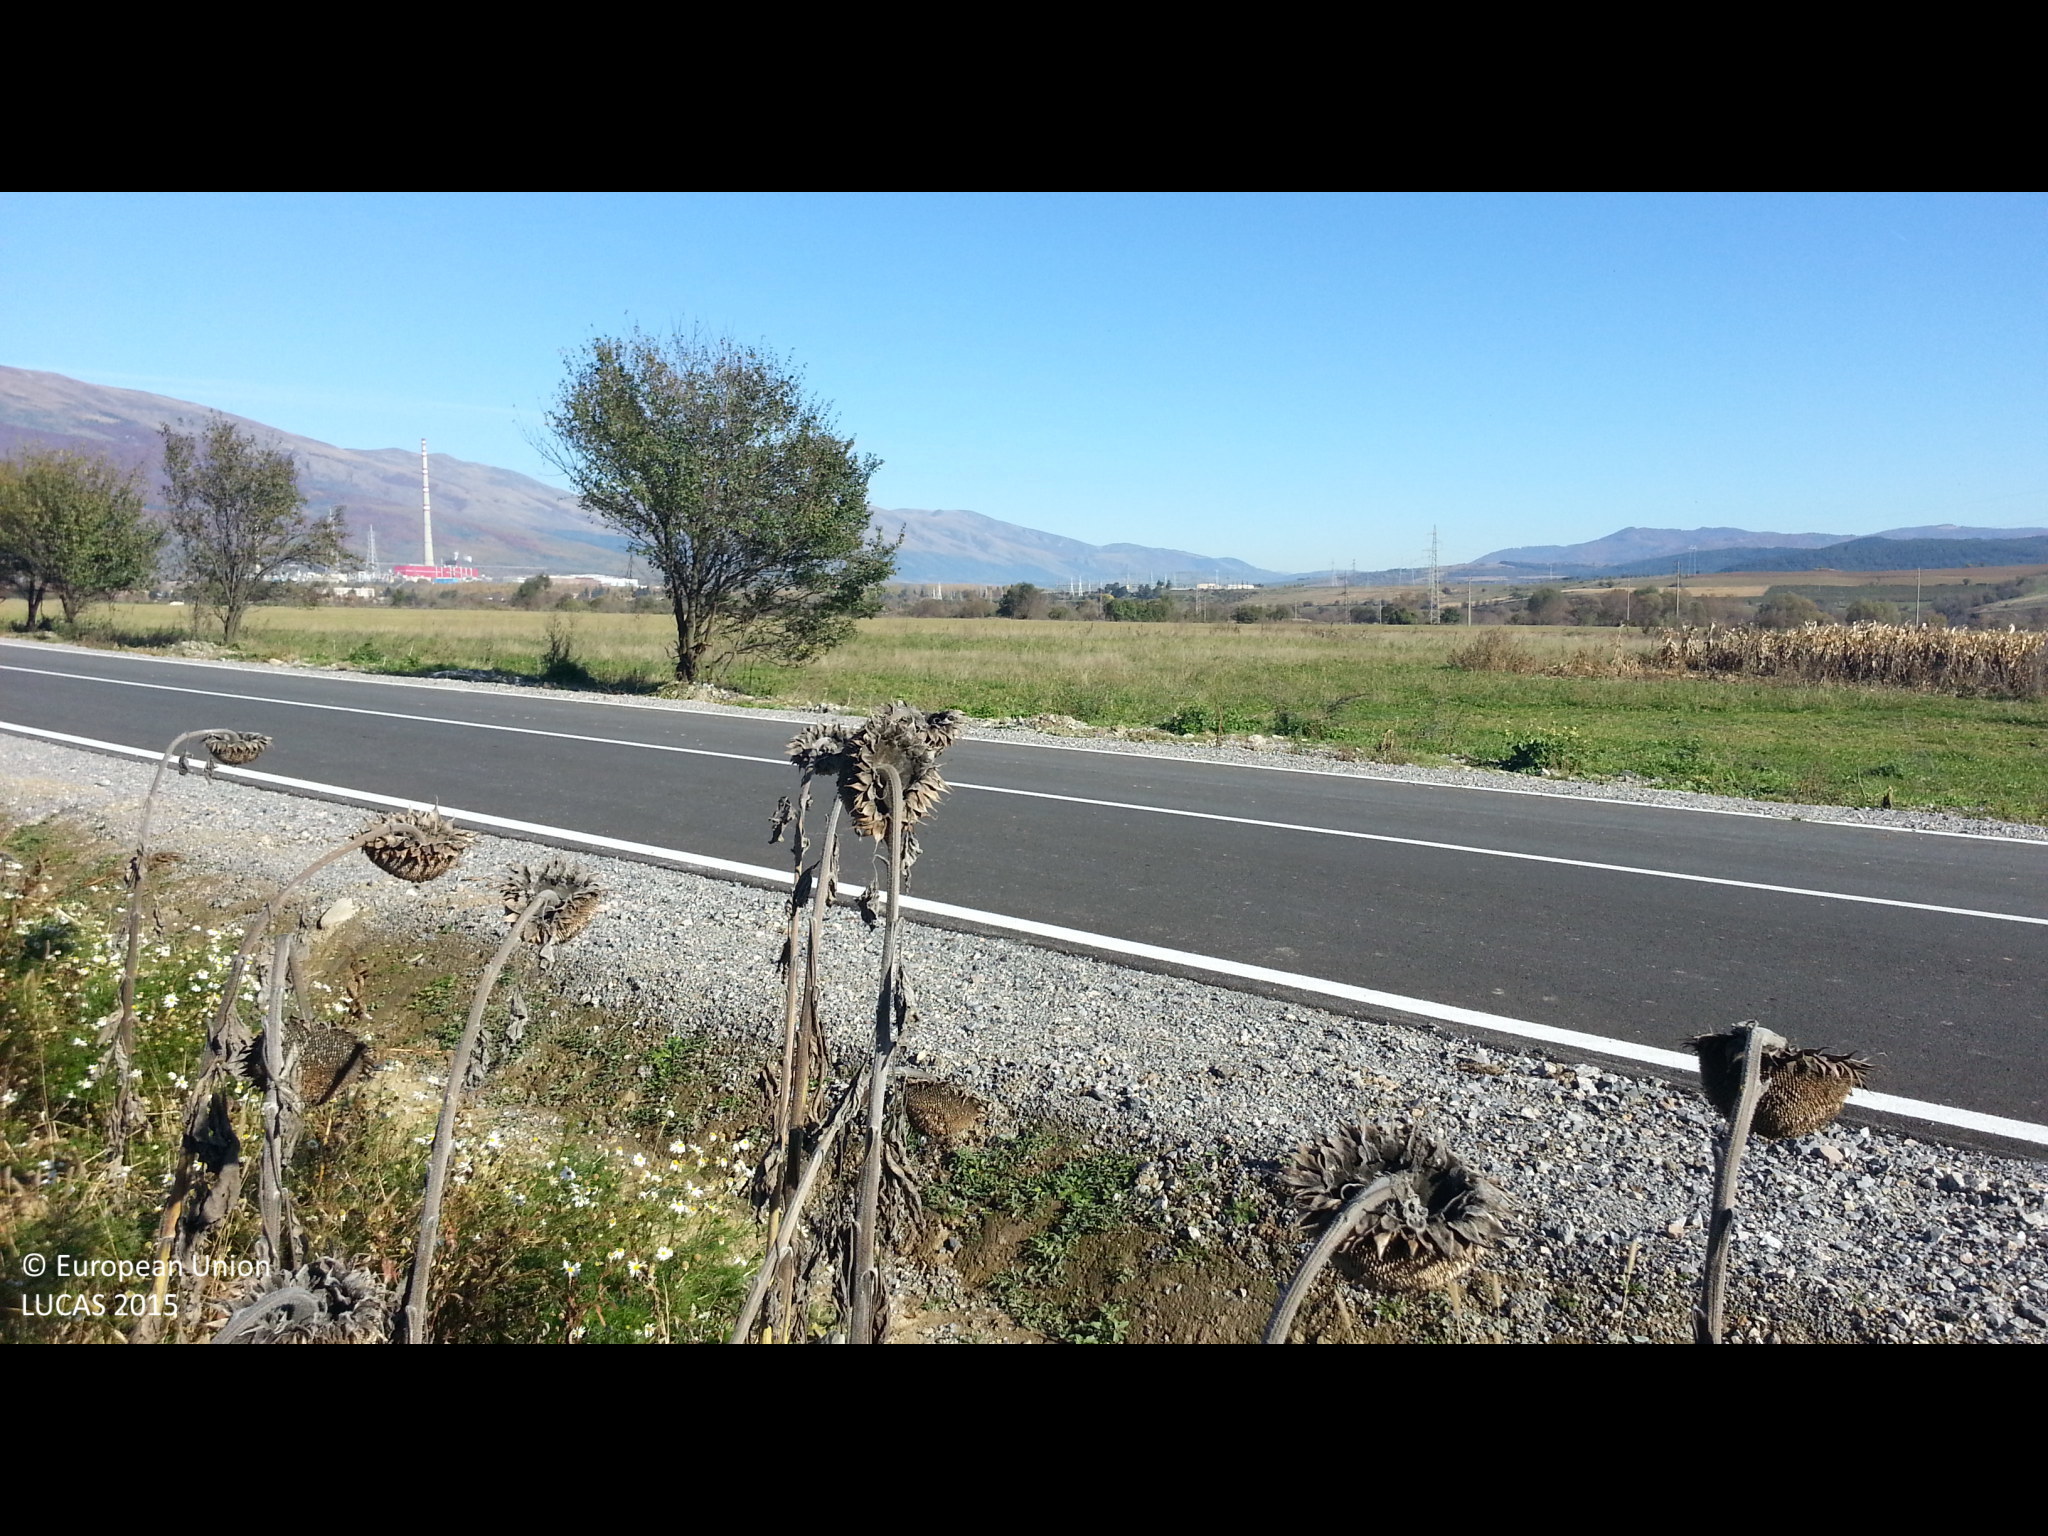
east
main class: Cropland
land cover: Sunflower
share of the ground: 50 - 75 %
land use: Agriculture (excluding fallow land and kitchen gardens)
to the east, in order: Sunflower; Grass margins; Paved roads, cycling and walking lanes; Grass margins; Lines of trees; Ditches and canals; Grassland without tree/shrub cover; Other bare soil; Common wheat
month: November
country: BG
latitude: 42.7022
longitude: 24.1225
